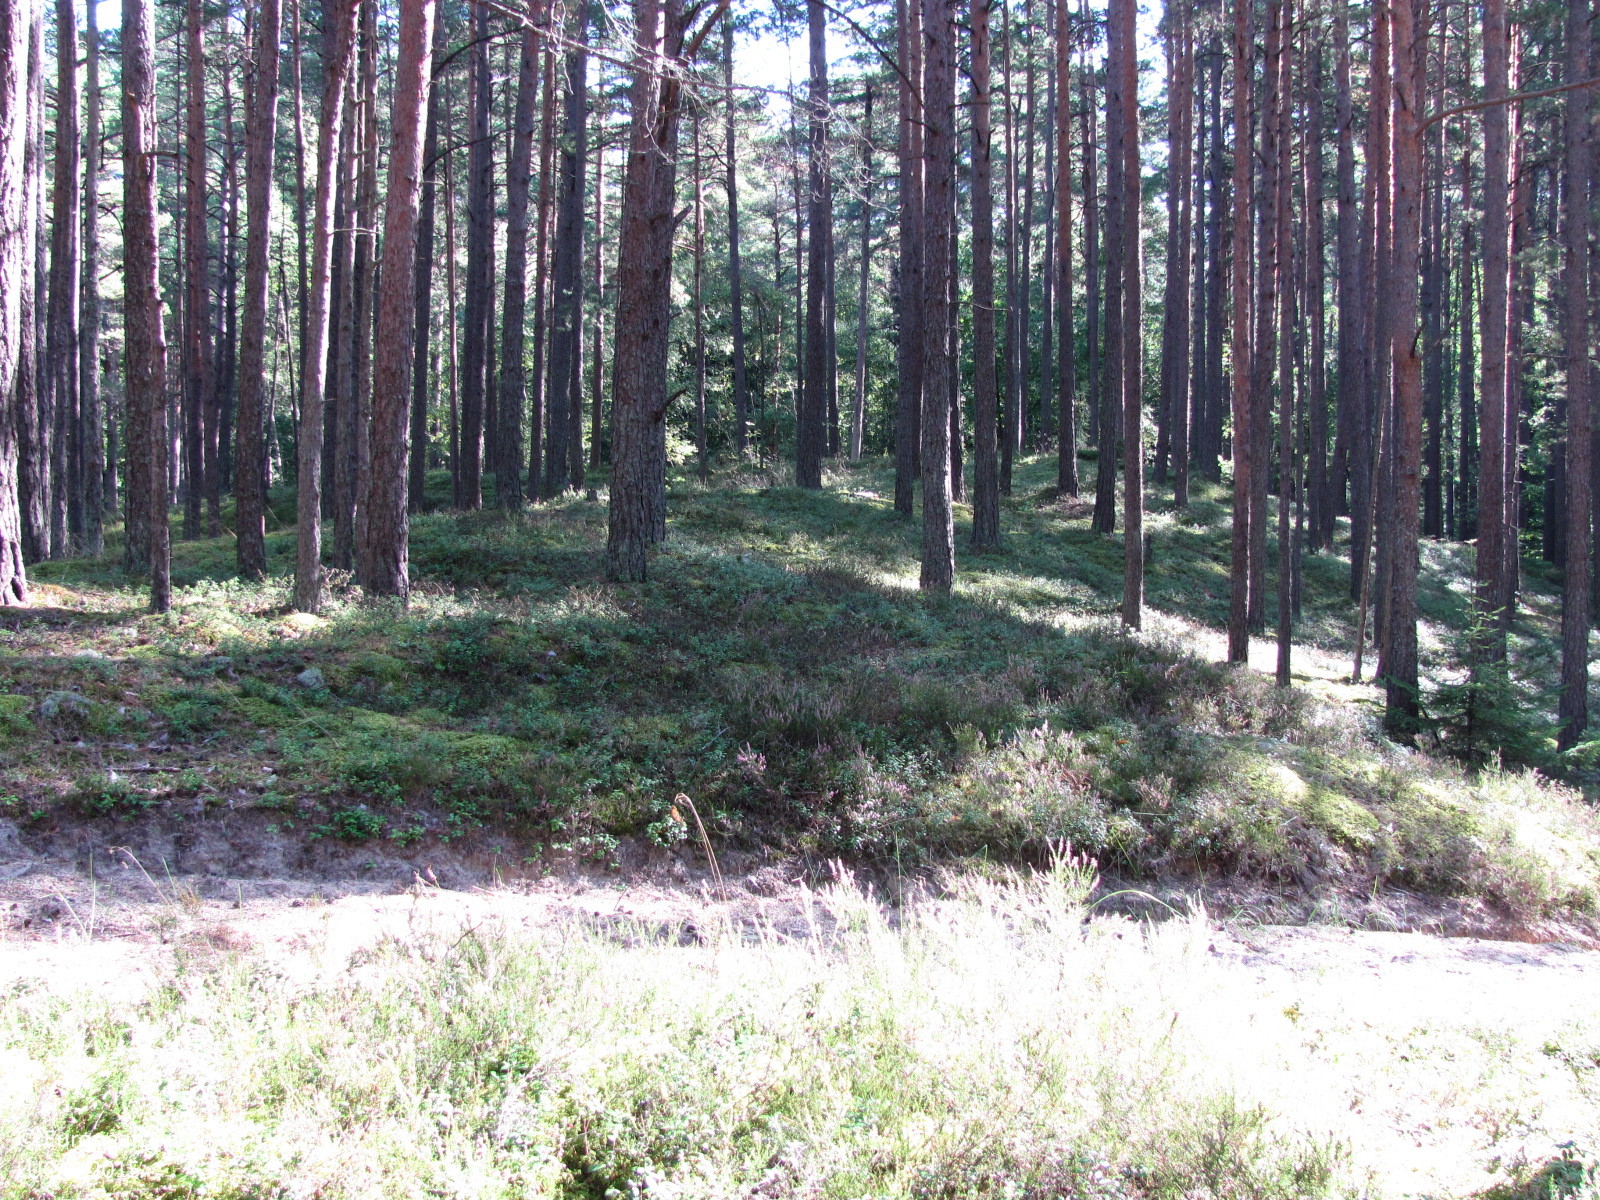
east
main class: Woodland
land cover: Pine dominated coniferous woodland
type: hemiboreal forest and nemoral coniferous forest and mixed broadleaved-coniferous forest
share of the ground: > 75 %
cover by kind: coniferous forest trees 80 %, herbaceous plants 10 %, lichens and mosses 10 %
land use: Forestry
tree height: > 5 m
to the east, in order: Pine dominated coniferous woodland; Tracks; Pine dominated coniferous woodland; Other mixed woodland; Inland fresh running water; Other coniferous woodland
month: September
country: LV
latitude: 57.1117
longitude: 24.2046
